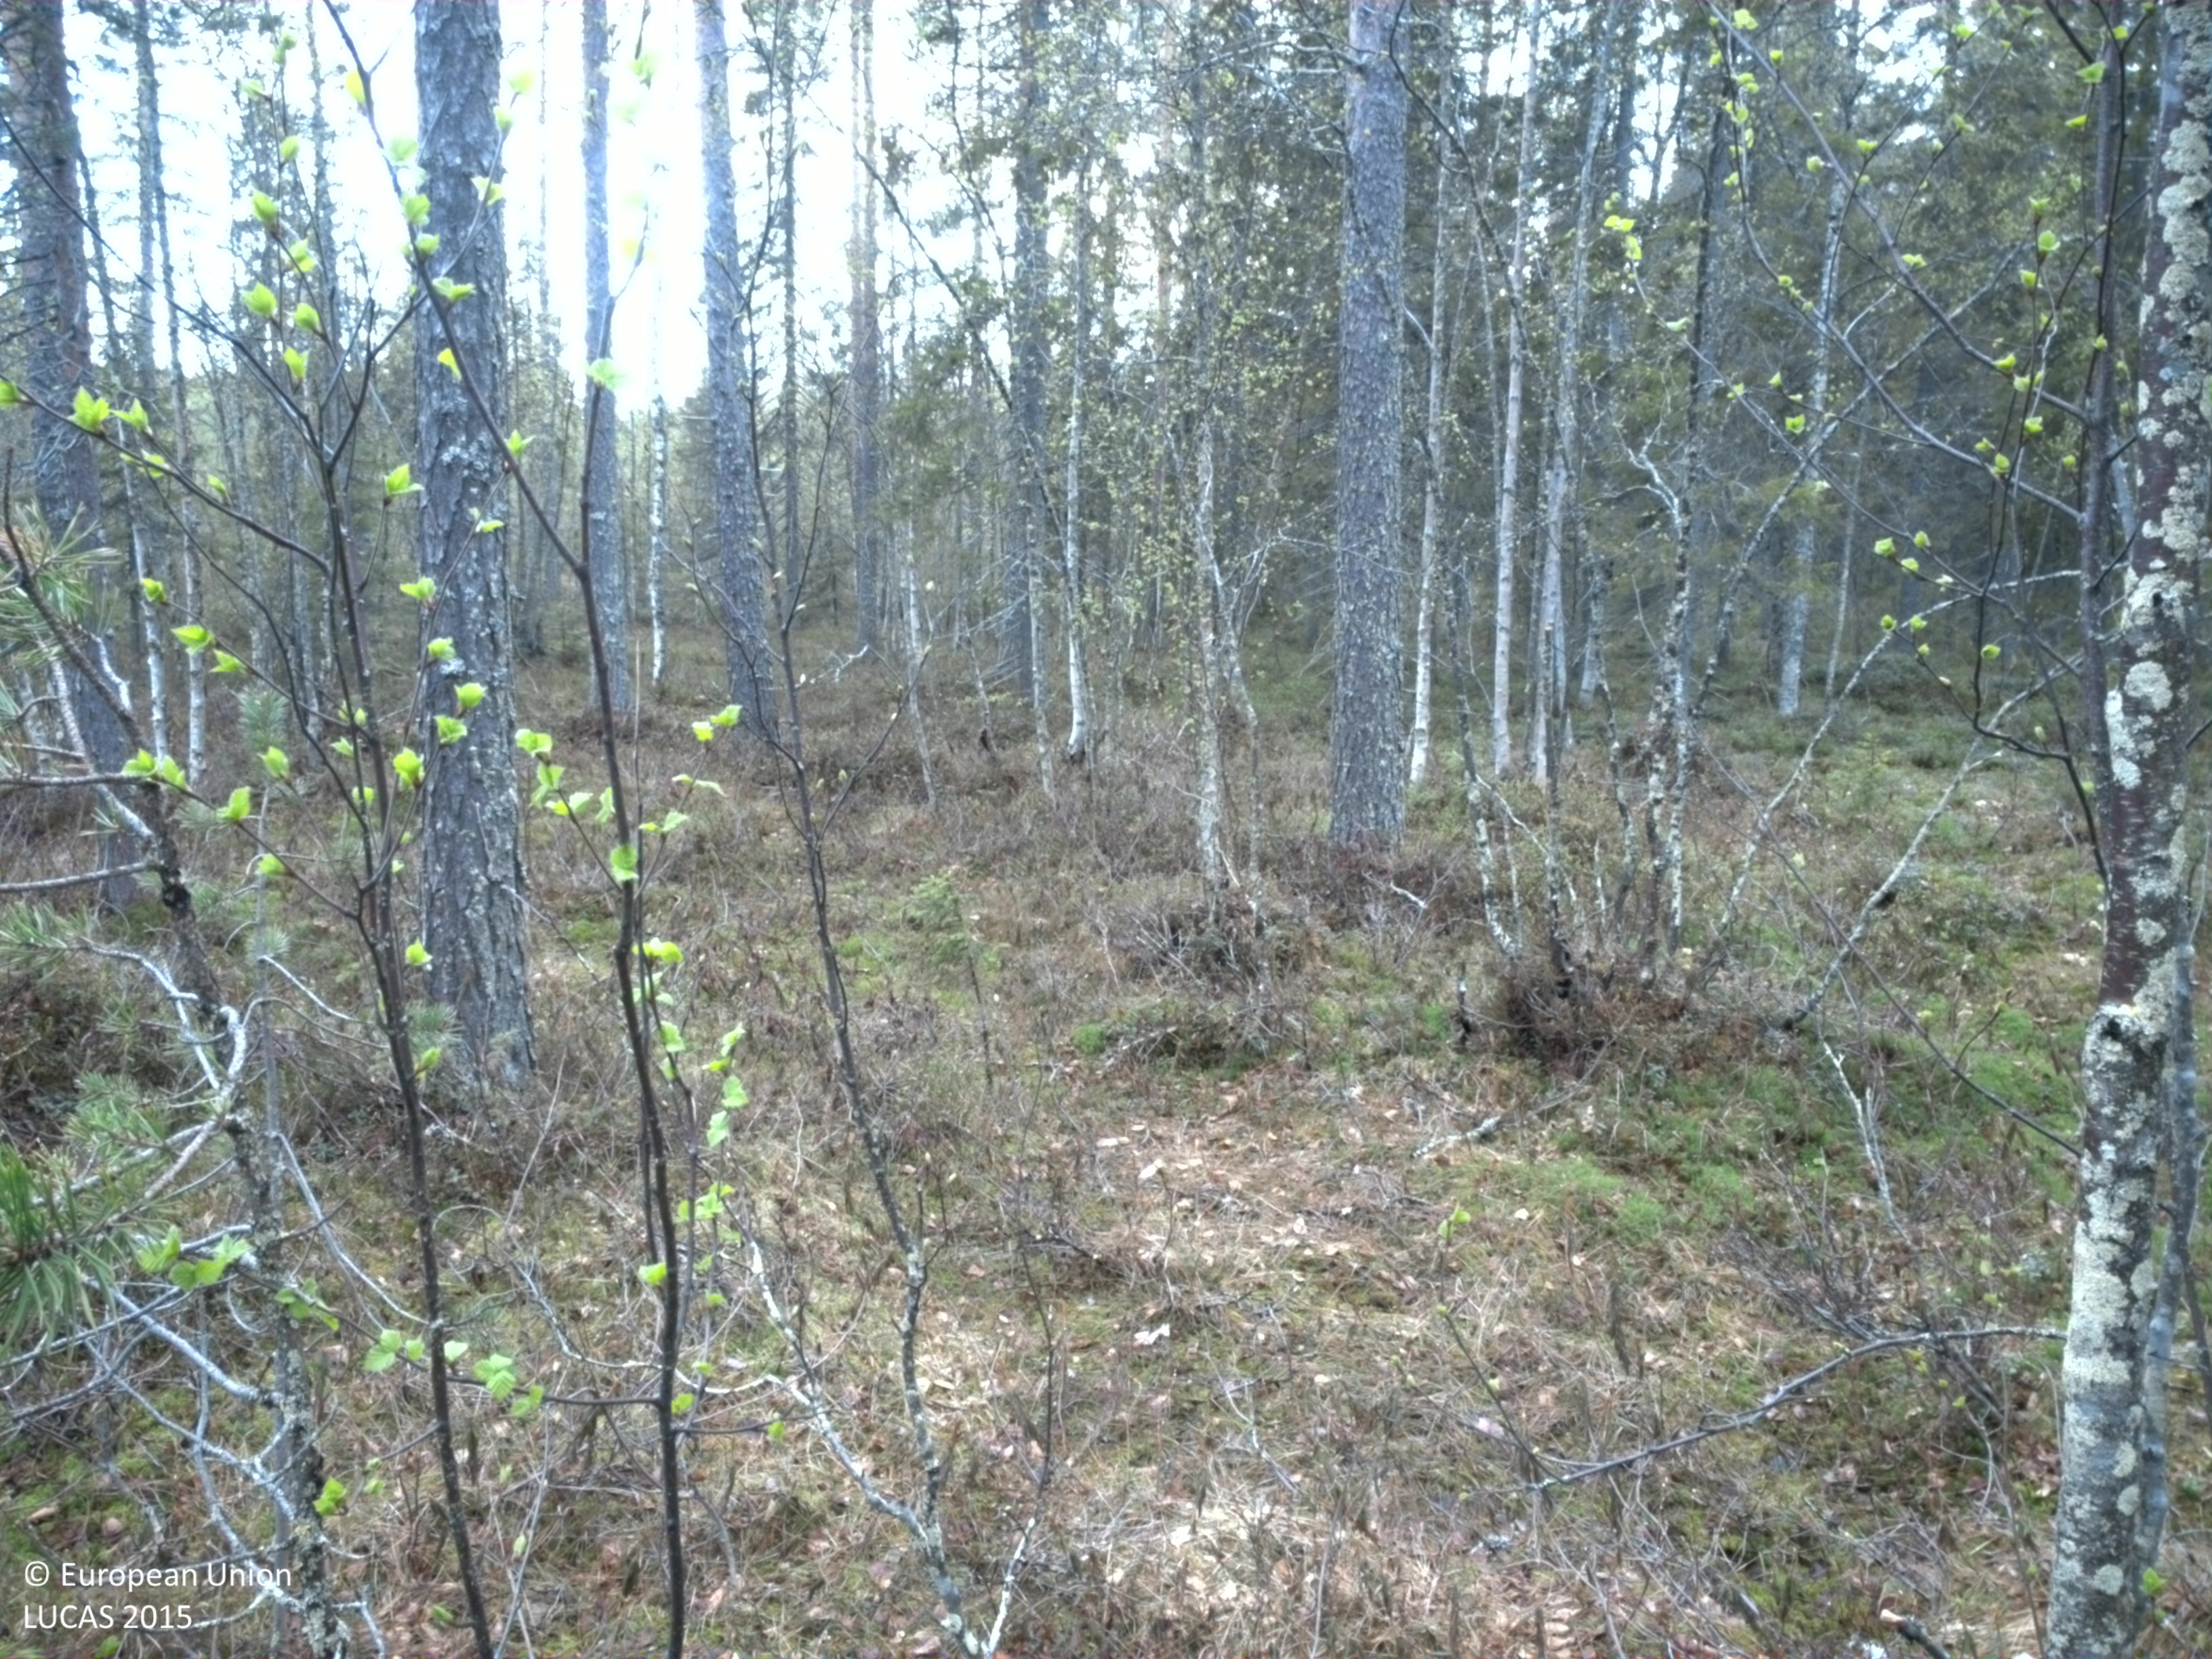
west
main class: Woodland
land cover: Pine dominated mixed woodland
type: mire and swamp forests
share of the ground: 25 - 50 %
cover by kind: shrubs 40 %, coniferous forest trees 25 %, broadleaved forest trees 25 %, herbaceous plants 5 %, lichens and mosses 5 %
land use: Forestry
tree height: > 5 m
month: May
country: SE
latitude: 66.0525
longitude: 23.1666
